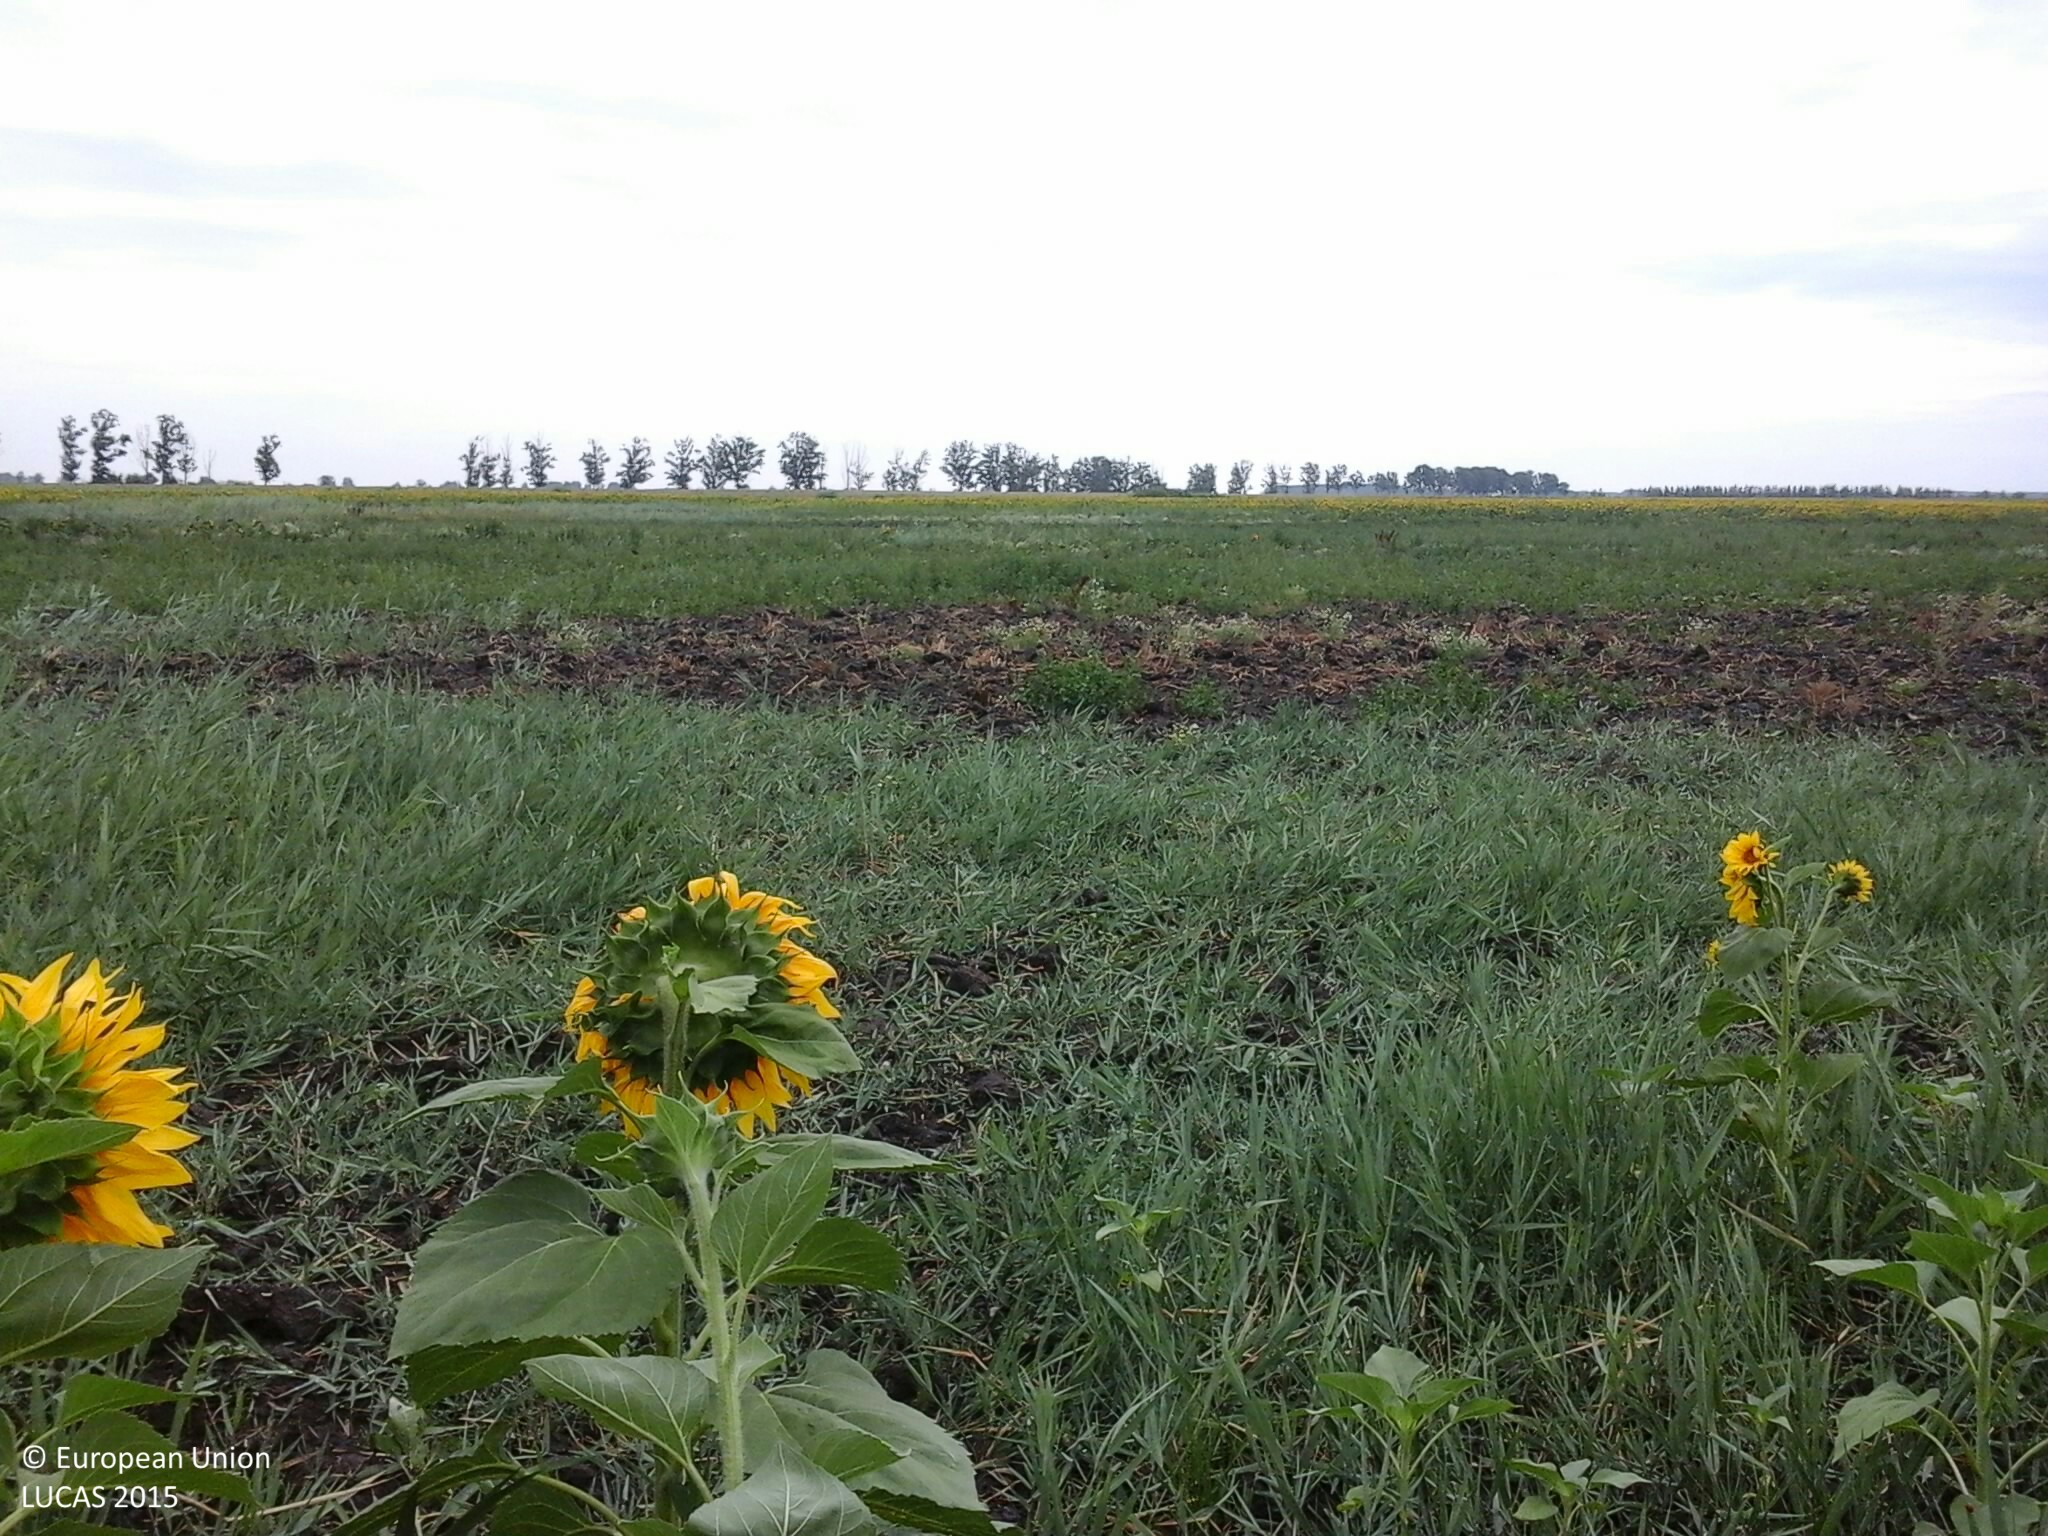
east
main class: Cropland
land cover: Sunflower
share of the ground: 50 - 75 %
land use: Agriculture (excluding fallow land and kitchen gardens)
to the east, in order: Sunflower; Spontaneously vegetated surfaces; Sunflower
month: July
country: HU
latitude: 46.9404
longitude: 20.3126
